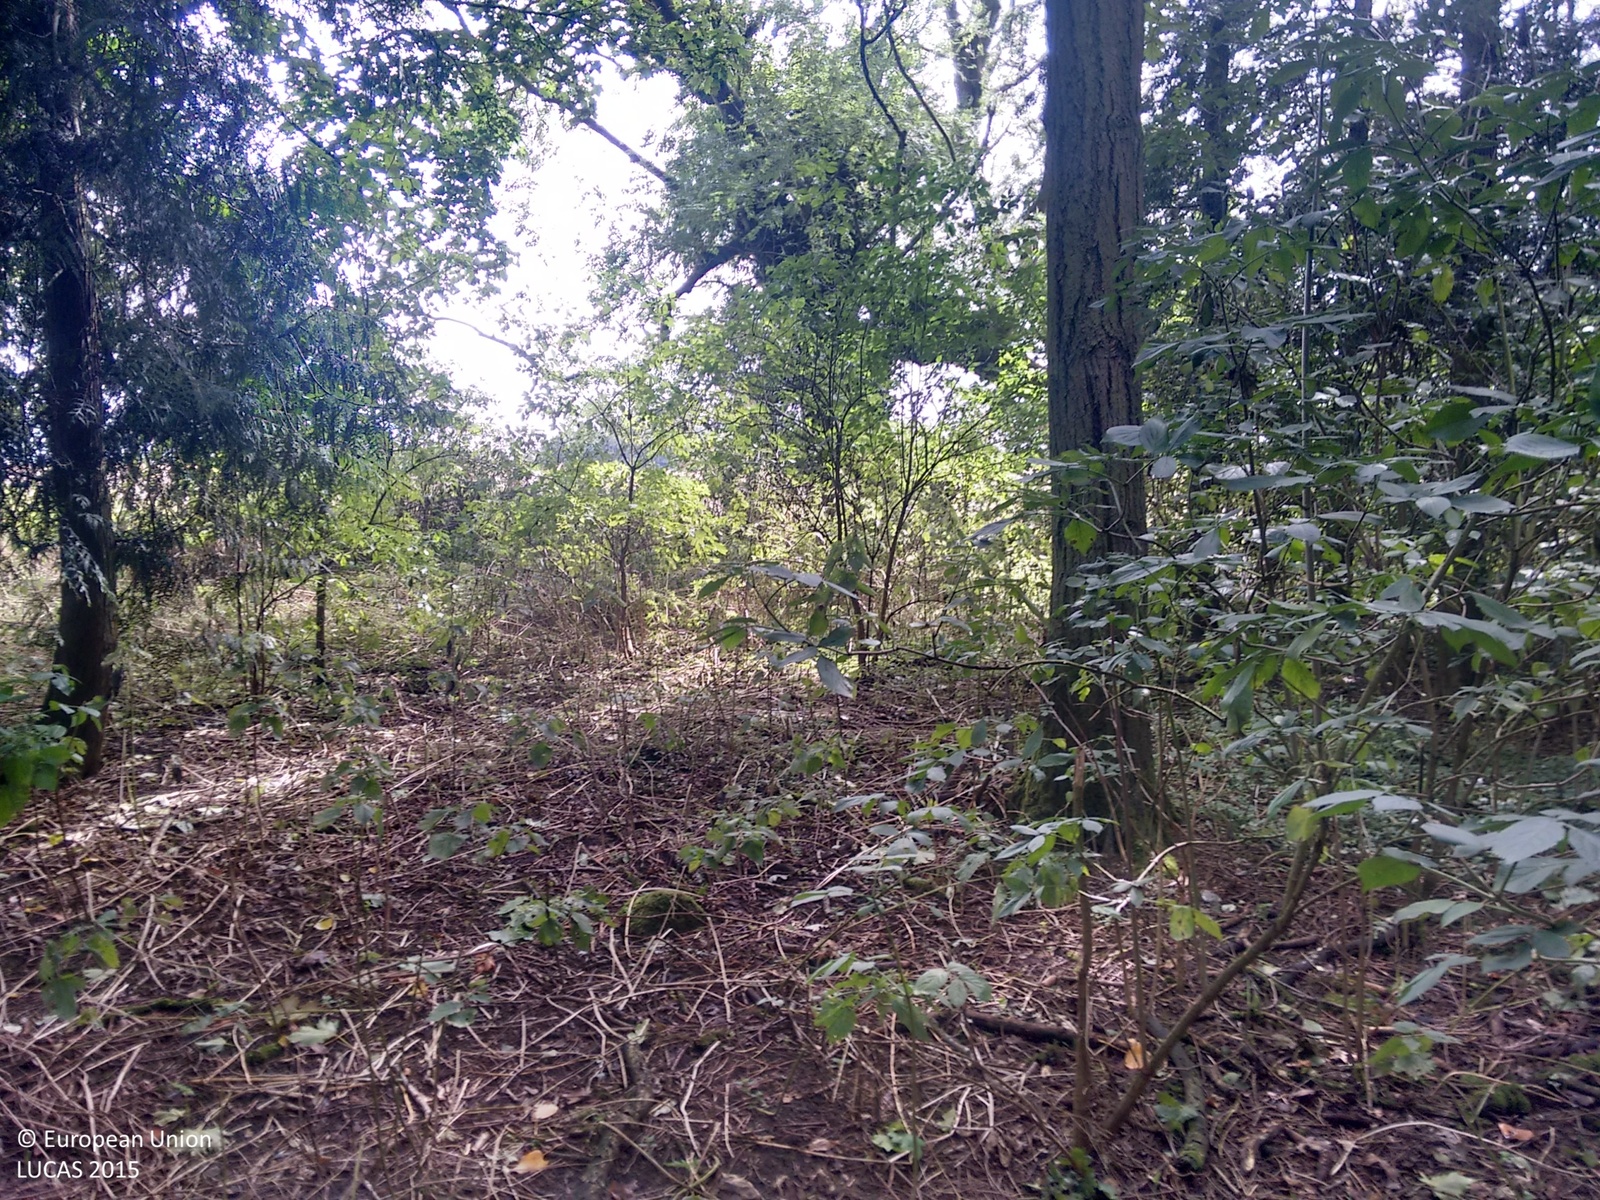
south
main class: Woodland
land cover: Other coniferous woodland
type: exotic forest
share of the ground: > 75 %
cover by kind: coniferous forest trees 85 %, shrubs 10 %, broadleaved forest trees 5 %
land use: Semi-natural and natural areas not in use
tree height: > 5 m
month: August
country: GB
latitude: 52.1598
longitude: 0.5146
